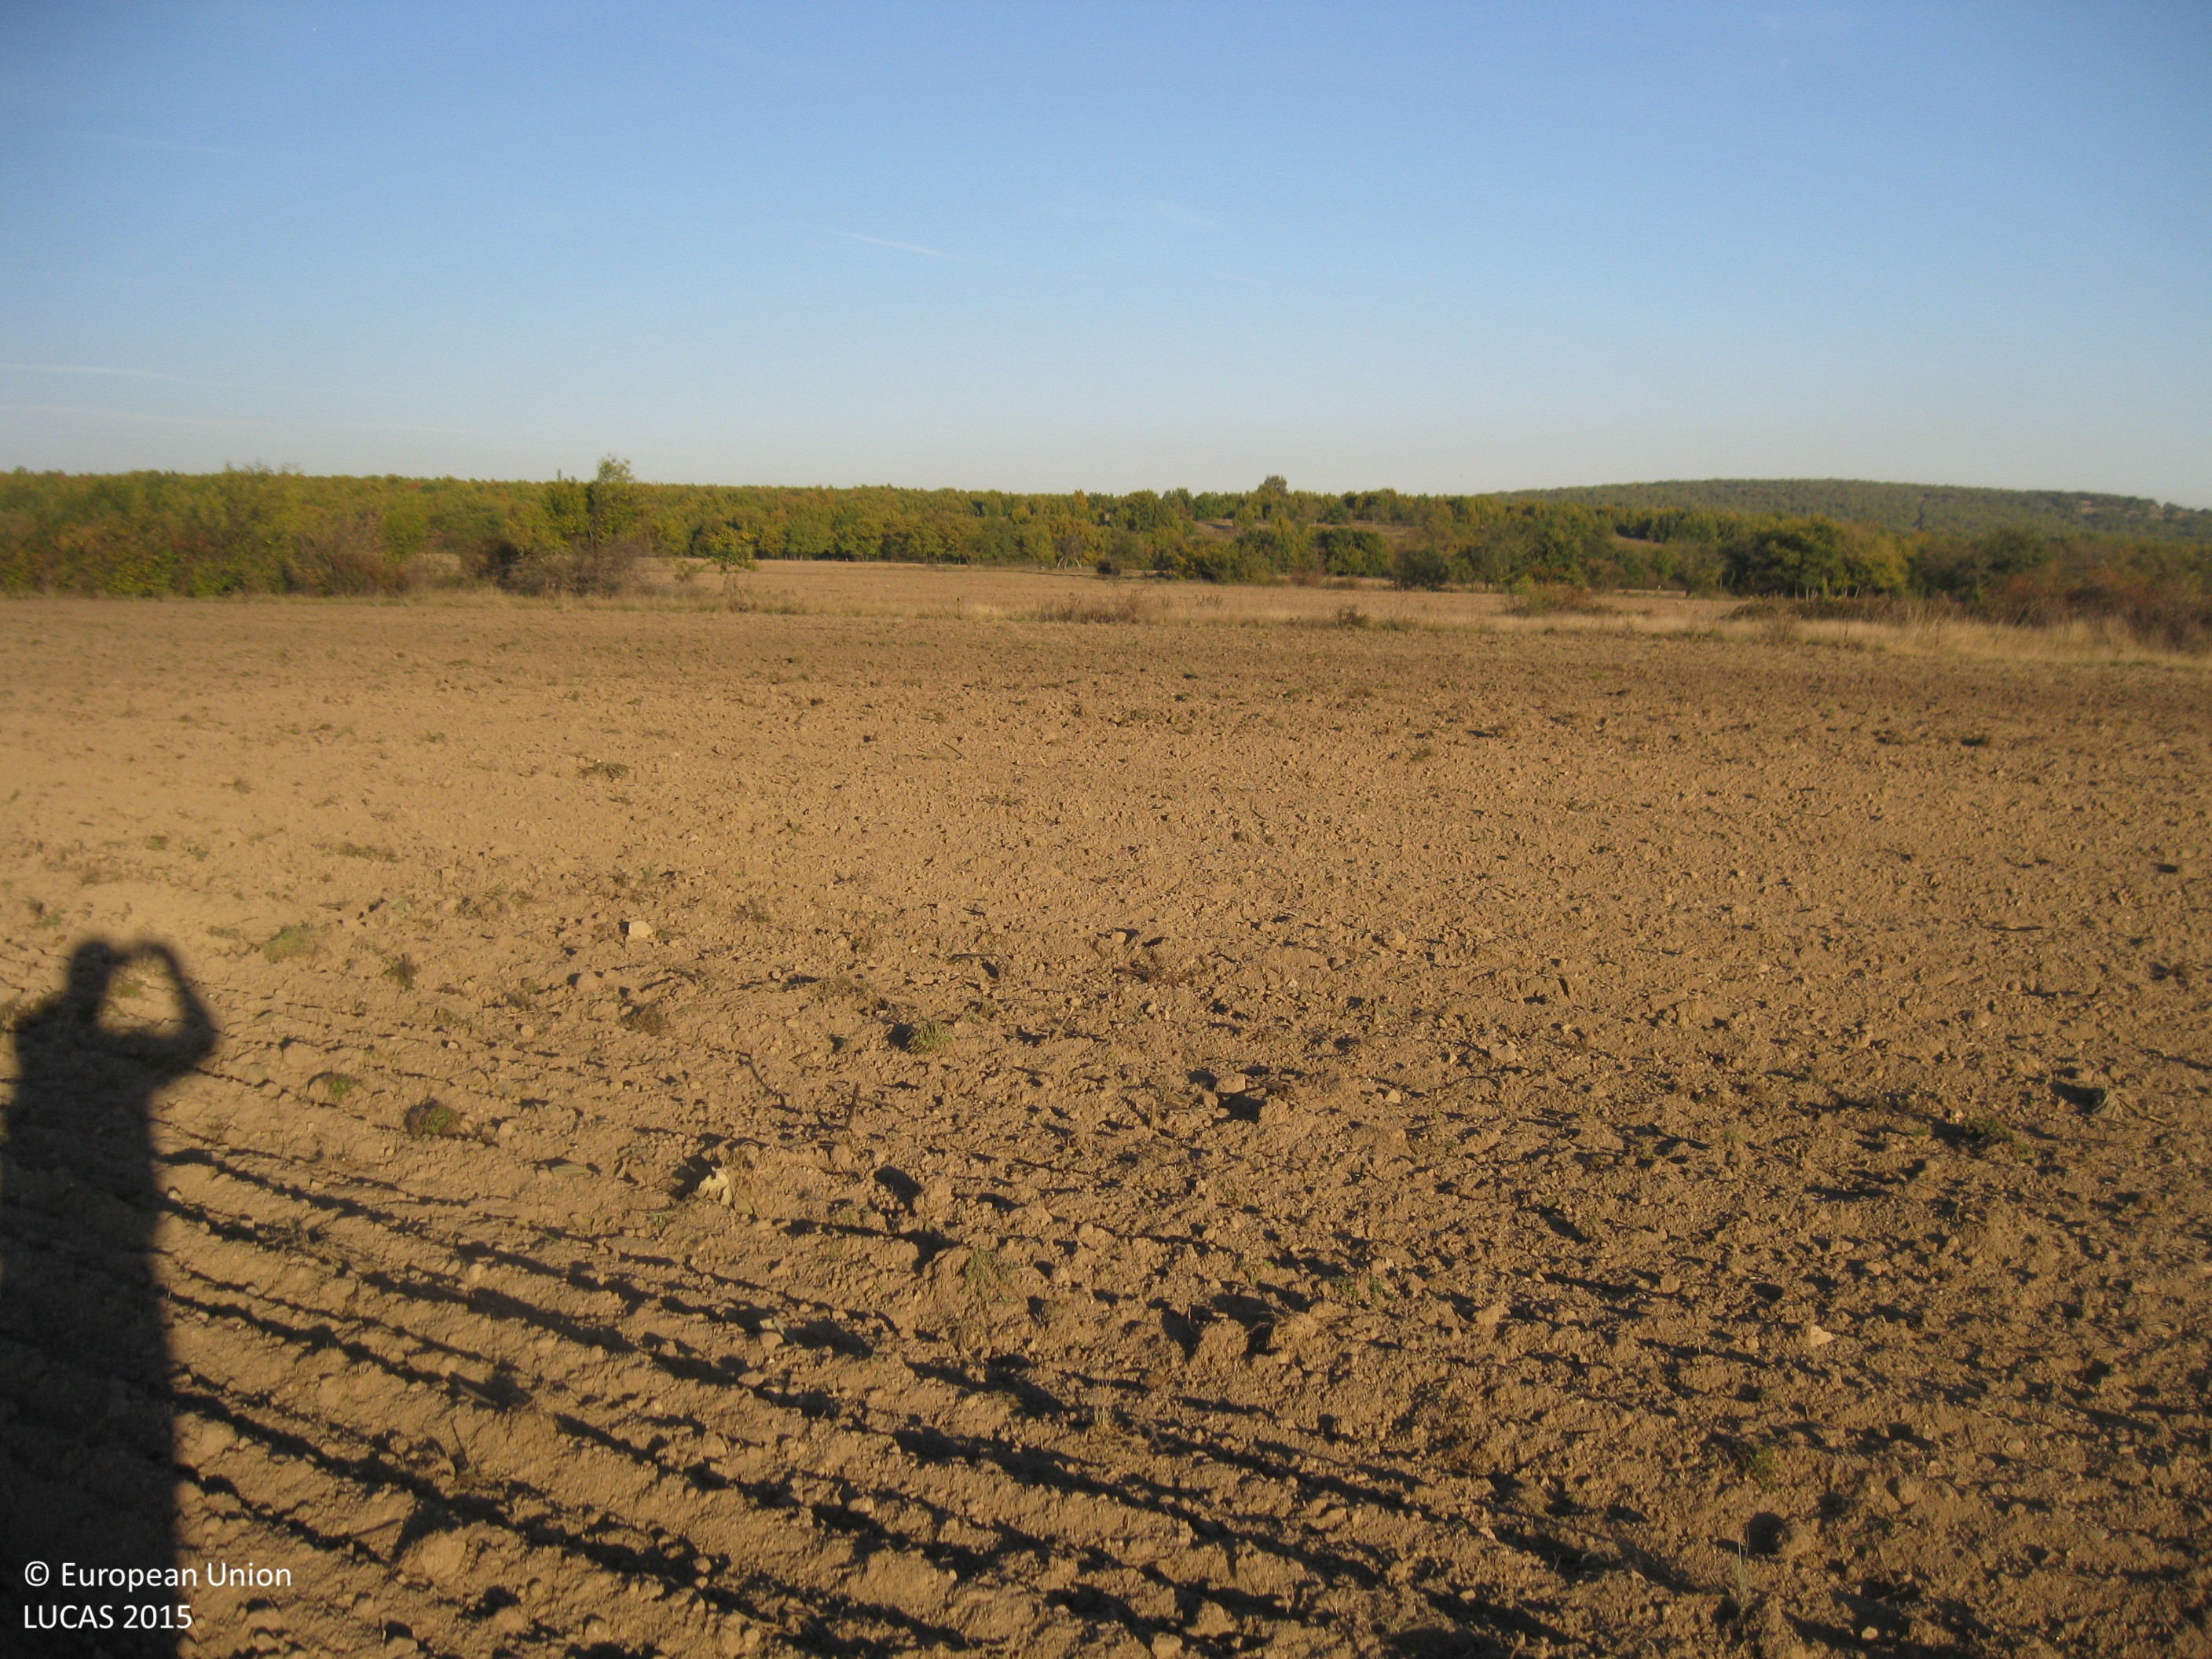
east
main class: Cropland
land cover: Sunflower
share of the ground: < 10 %
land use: Agriculture (excluding fallow land and kitchen gardens)
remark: Harvested field
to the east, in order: Sunflower; Grassland without tree/shrub cover; Sunflower; Shrubland with sparse tree cover; Sunflower
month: November
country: BG
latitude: 42.3210
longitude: 24.2291
